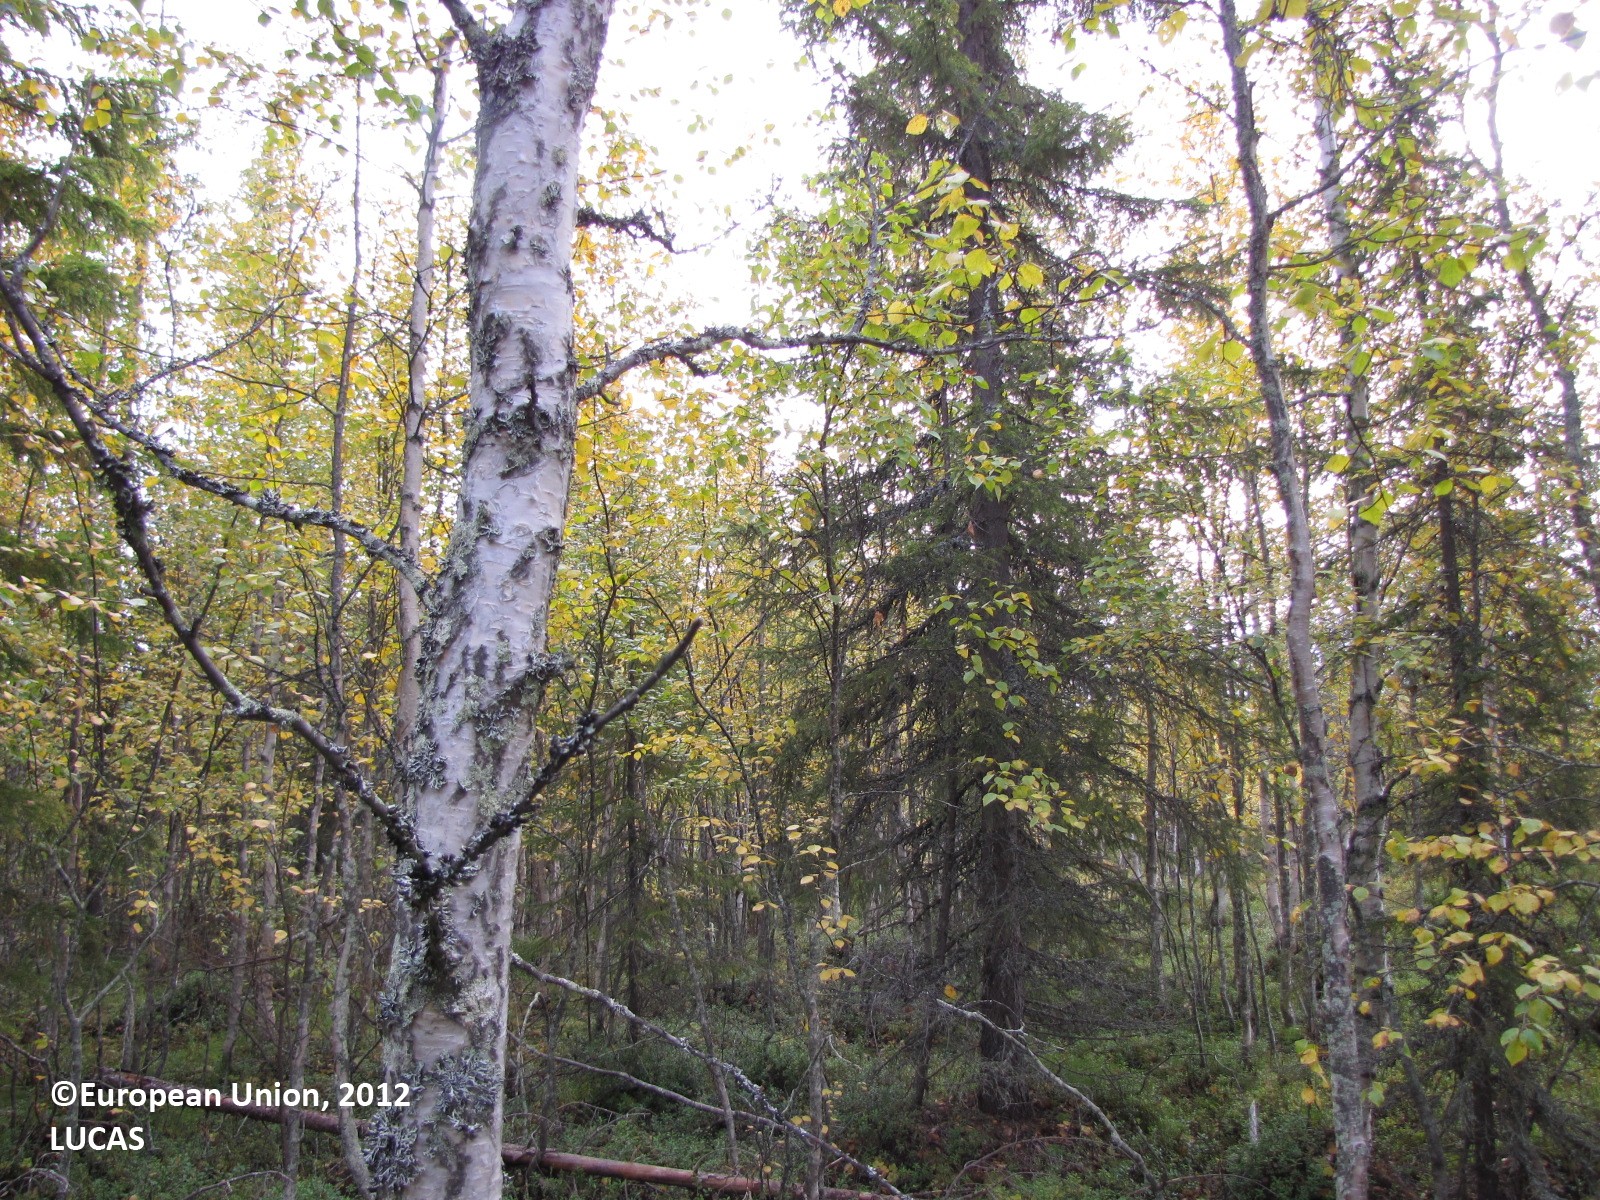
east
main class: Woodland
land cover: Spruce dominated mixed woodland
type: boreal forest
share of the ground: 25 - 50 %
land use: Forestry
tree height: > 5 m
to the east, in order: Spruce dominated mixed woodland; Pine dominated mixed woodland; Paved roads, cycling and walking lanes; Pine dominated mixed woodland
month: September
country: FI
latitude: 67.3608
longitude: 25.2006
